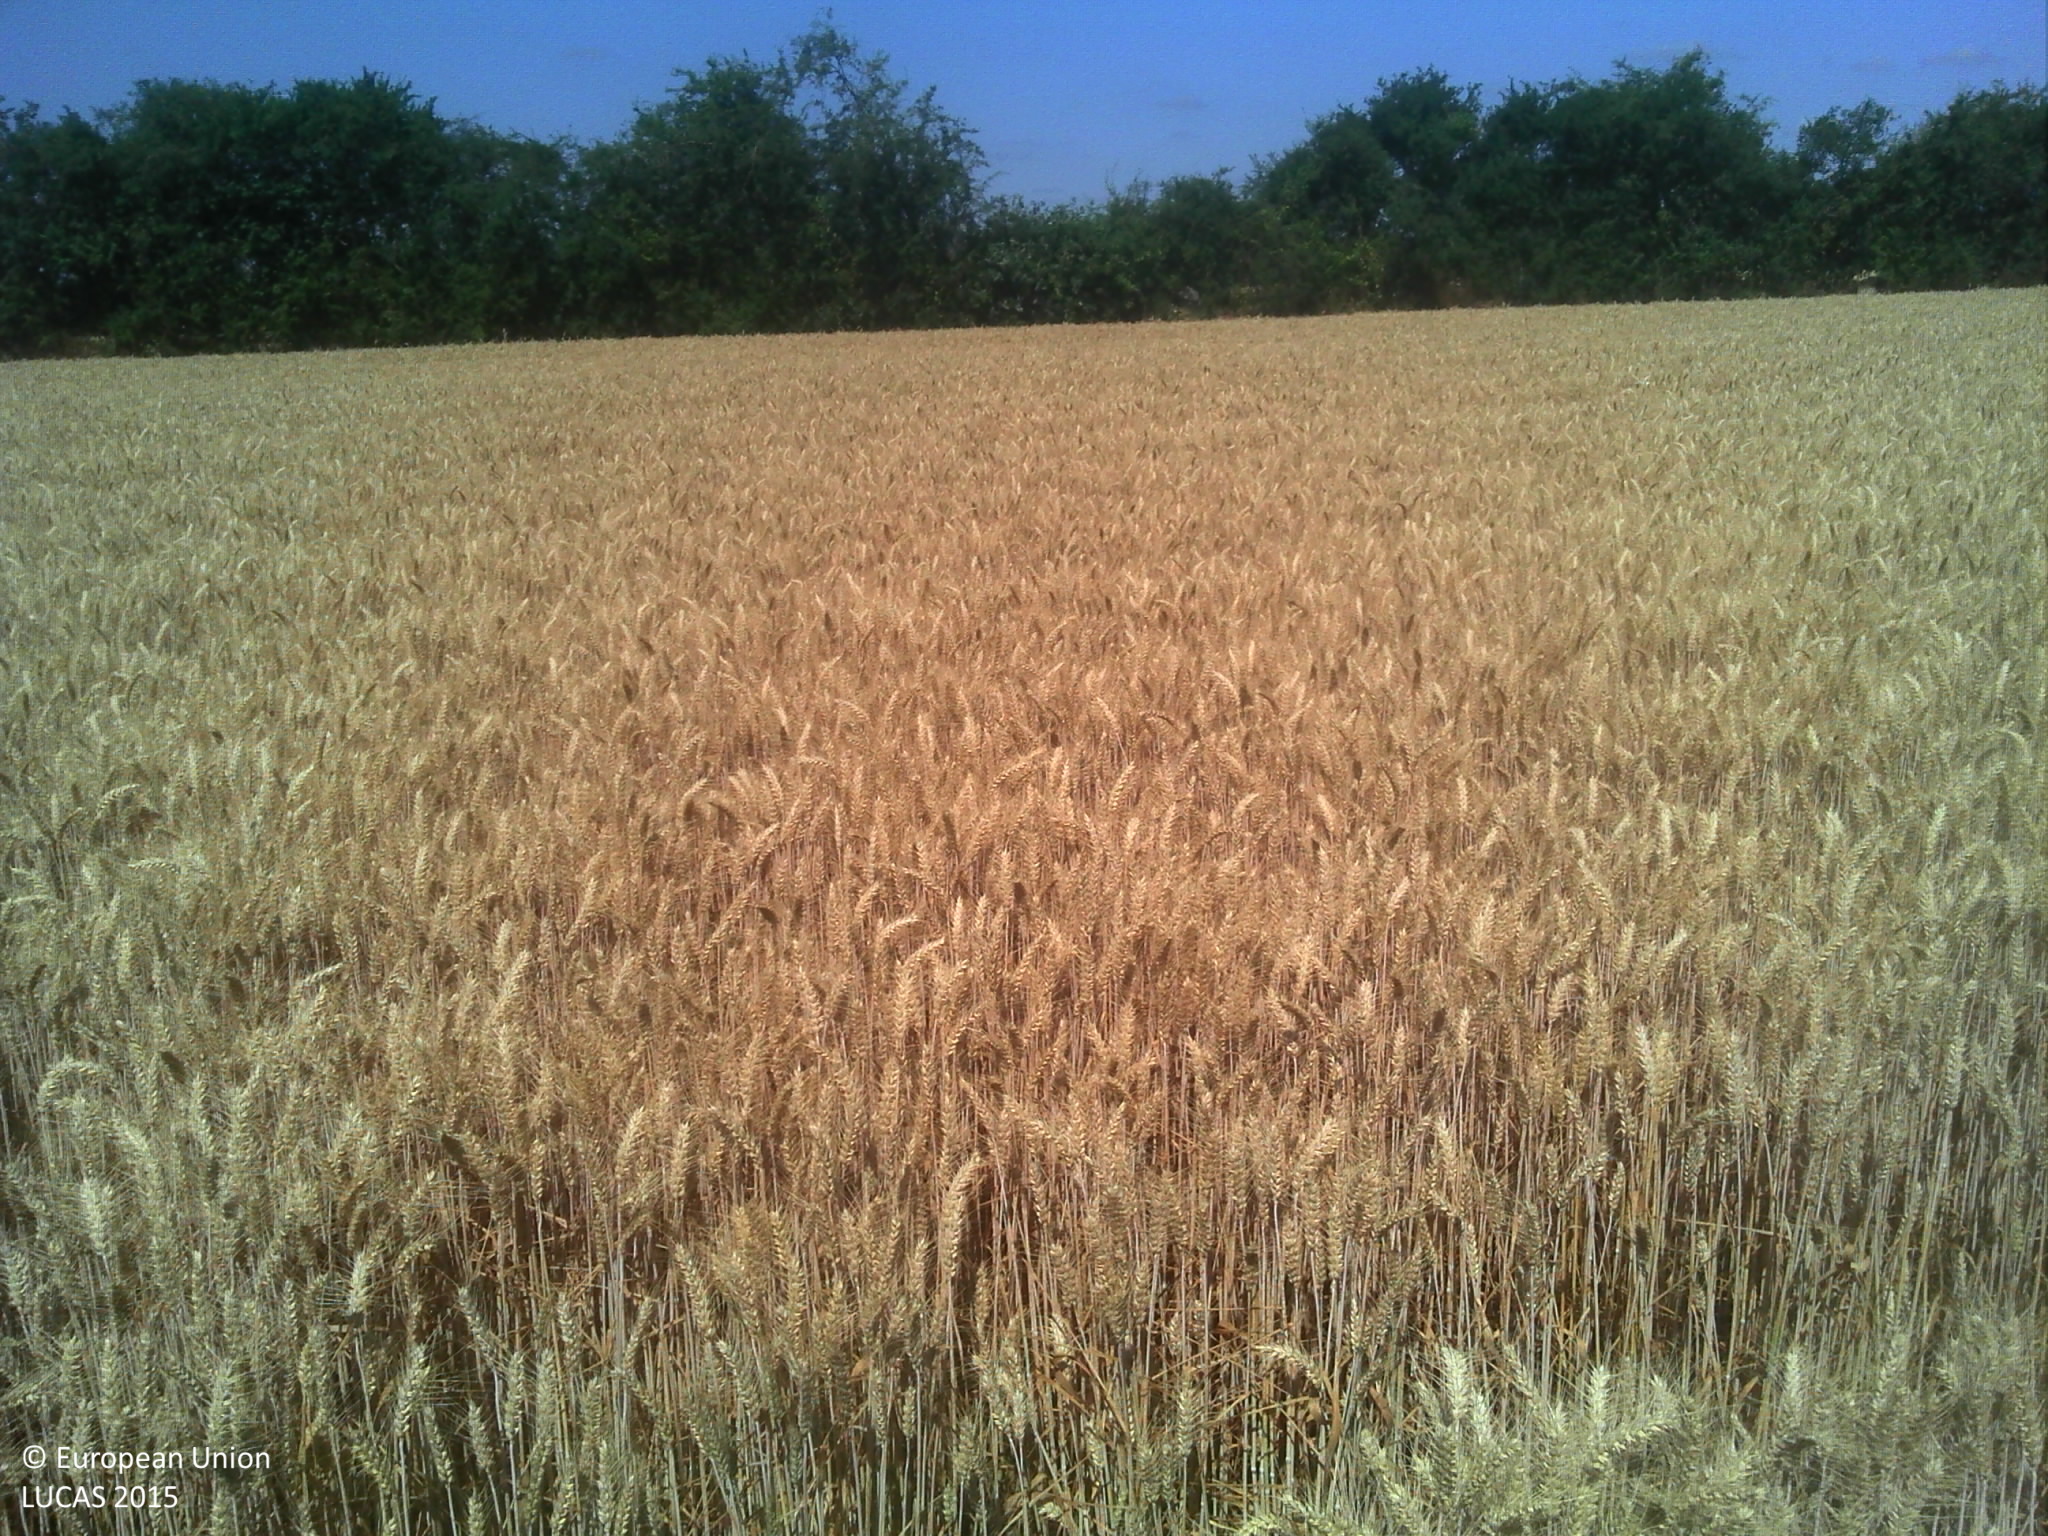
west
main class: Cropland
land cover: Durum wheat
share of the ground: > 75 %
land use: Agriculture (excluding fallow land and kitchen gardens)
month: July
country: FR
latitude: 47.9898
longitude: 0.8814
